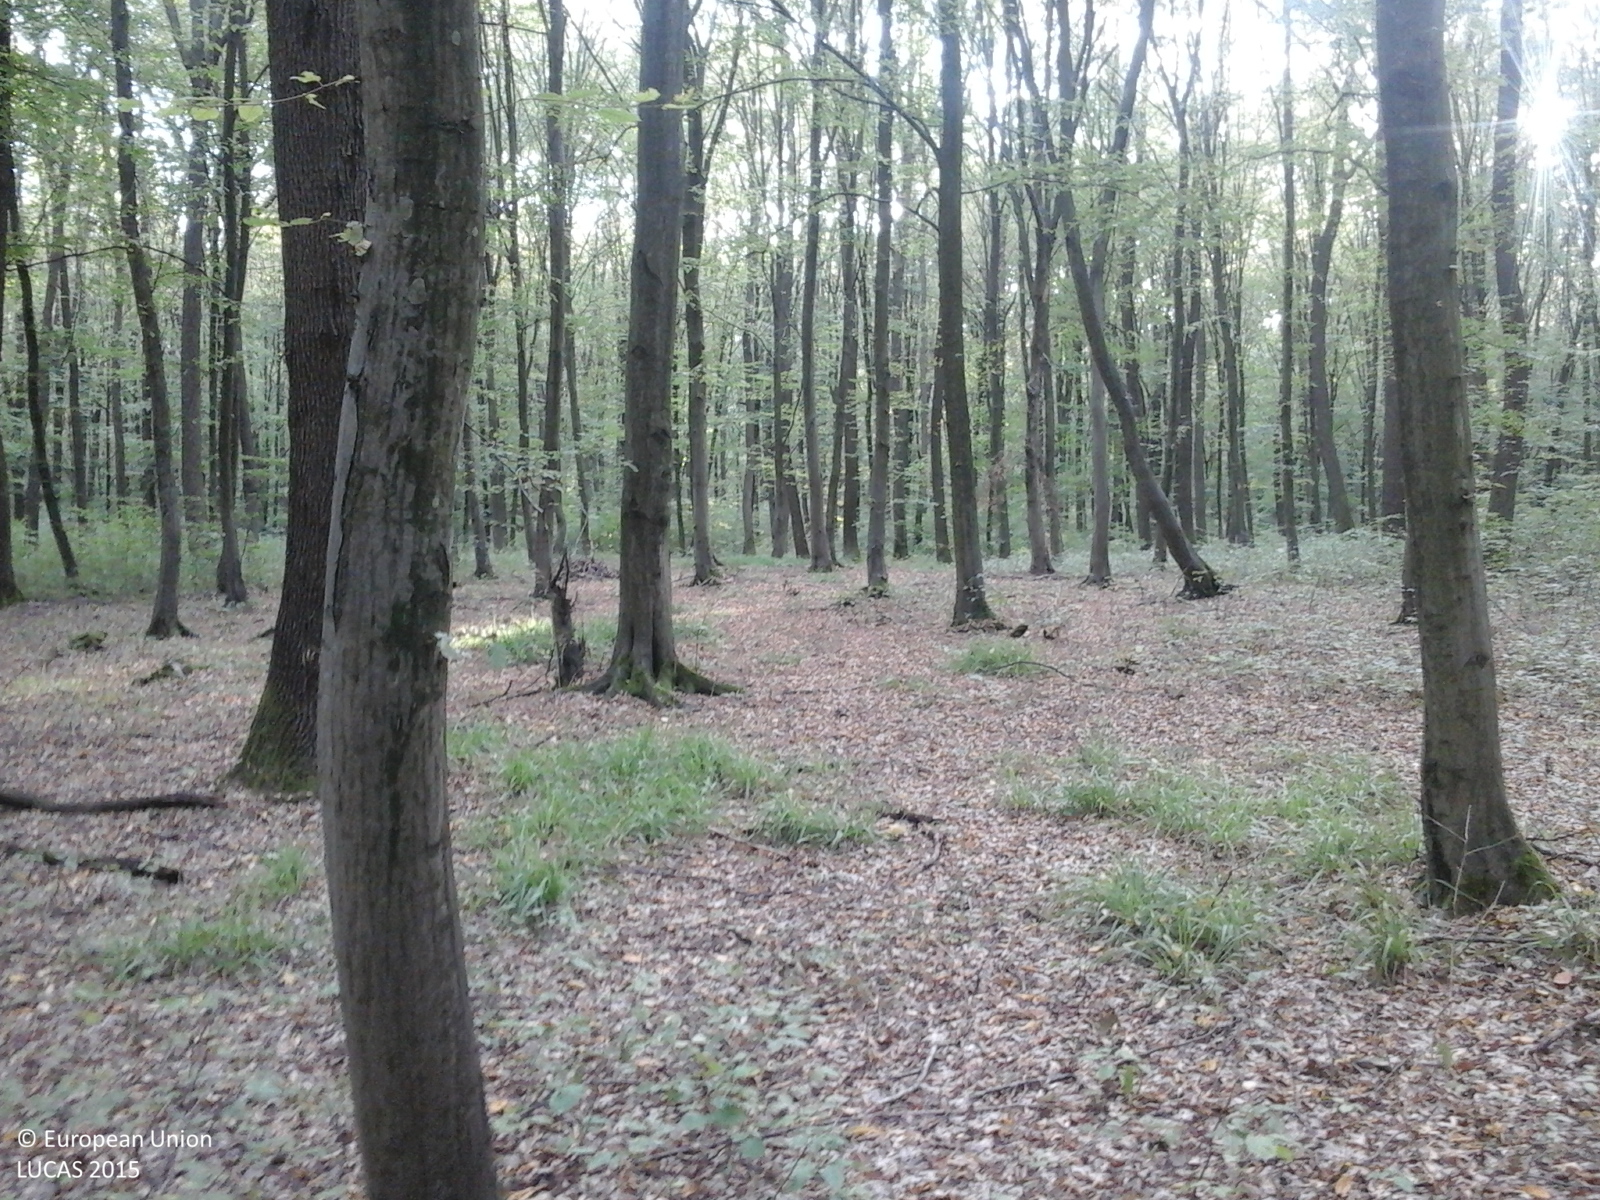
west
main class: Woodland
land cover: Broadleaved woodland
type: beech forest
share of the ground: > 75 %
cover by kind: broadleaved forest trees 100 %
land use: Forestry
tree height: > 5 m
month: September
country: RO
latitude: 47.6240
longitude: 23.3653
